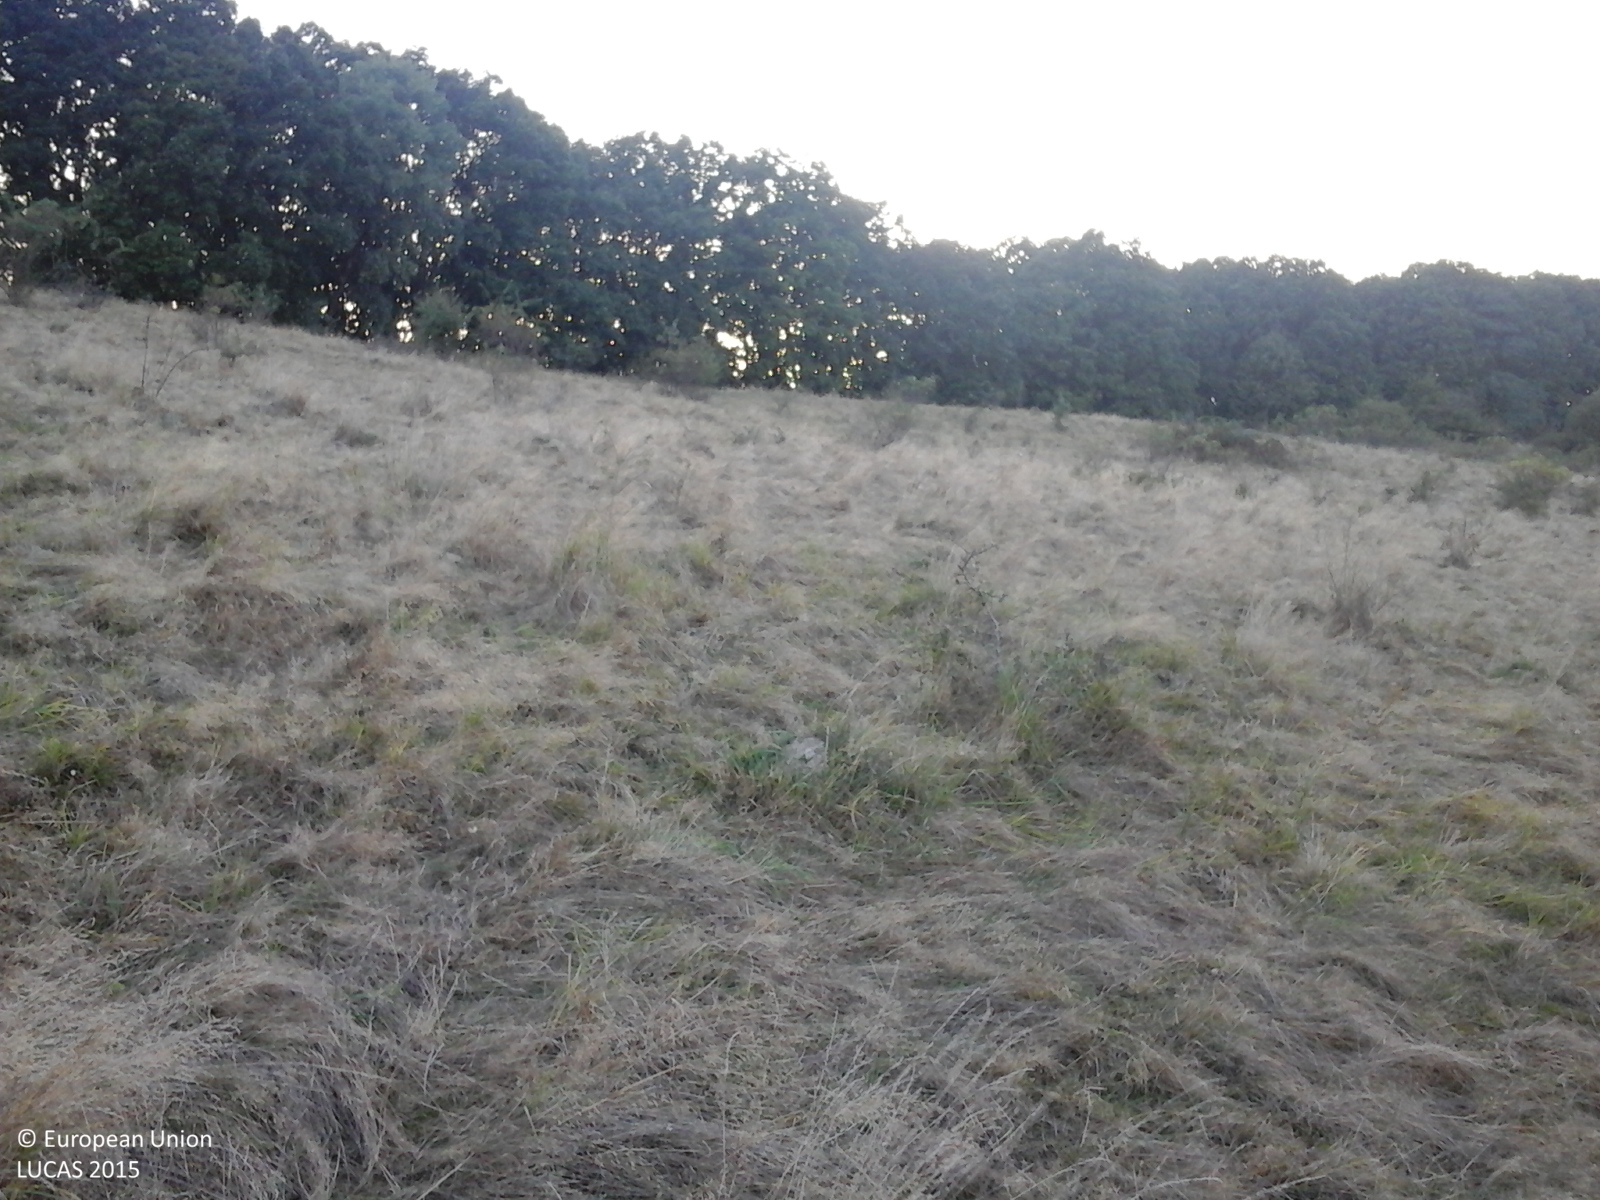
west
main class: Grassland
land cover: Grassland with sparse tree/shrub cover
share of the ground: > 75 %
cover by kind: herbaceous plants 85 %, shrubs 10 %, broadleaved forest trees 5 %
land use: Agriculture (excluding fallow land and kitchen gardens)
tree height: < 5 m
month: September
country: RO
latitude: 47.0825
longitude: 23.4660
